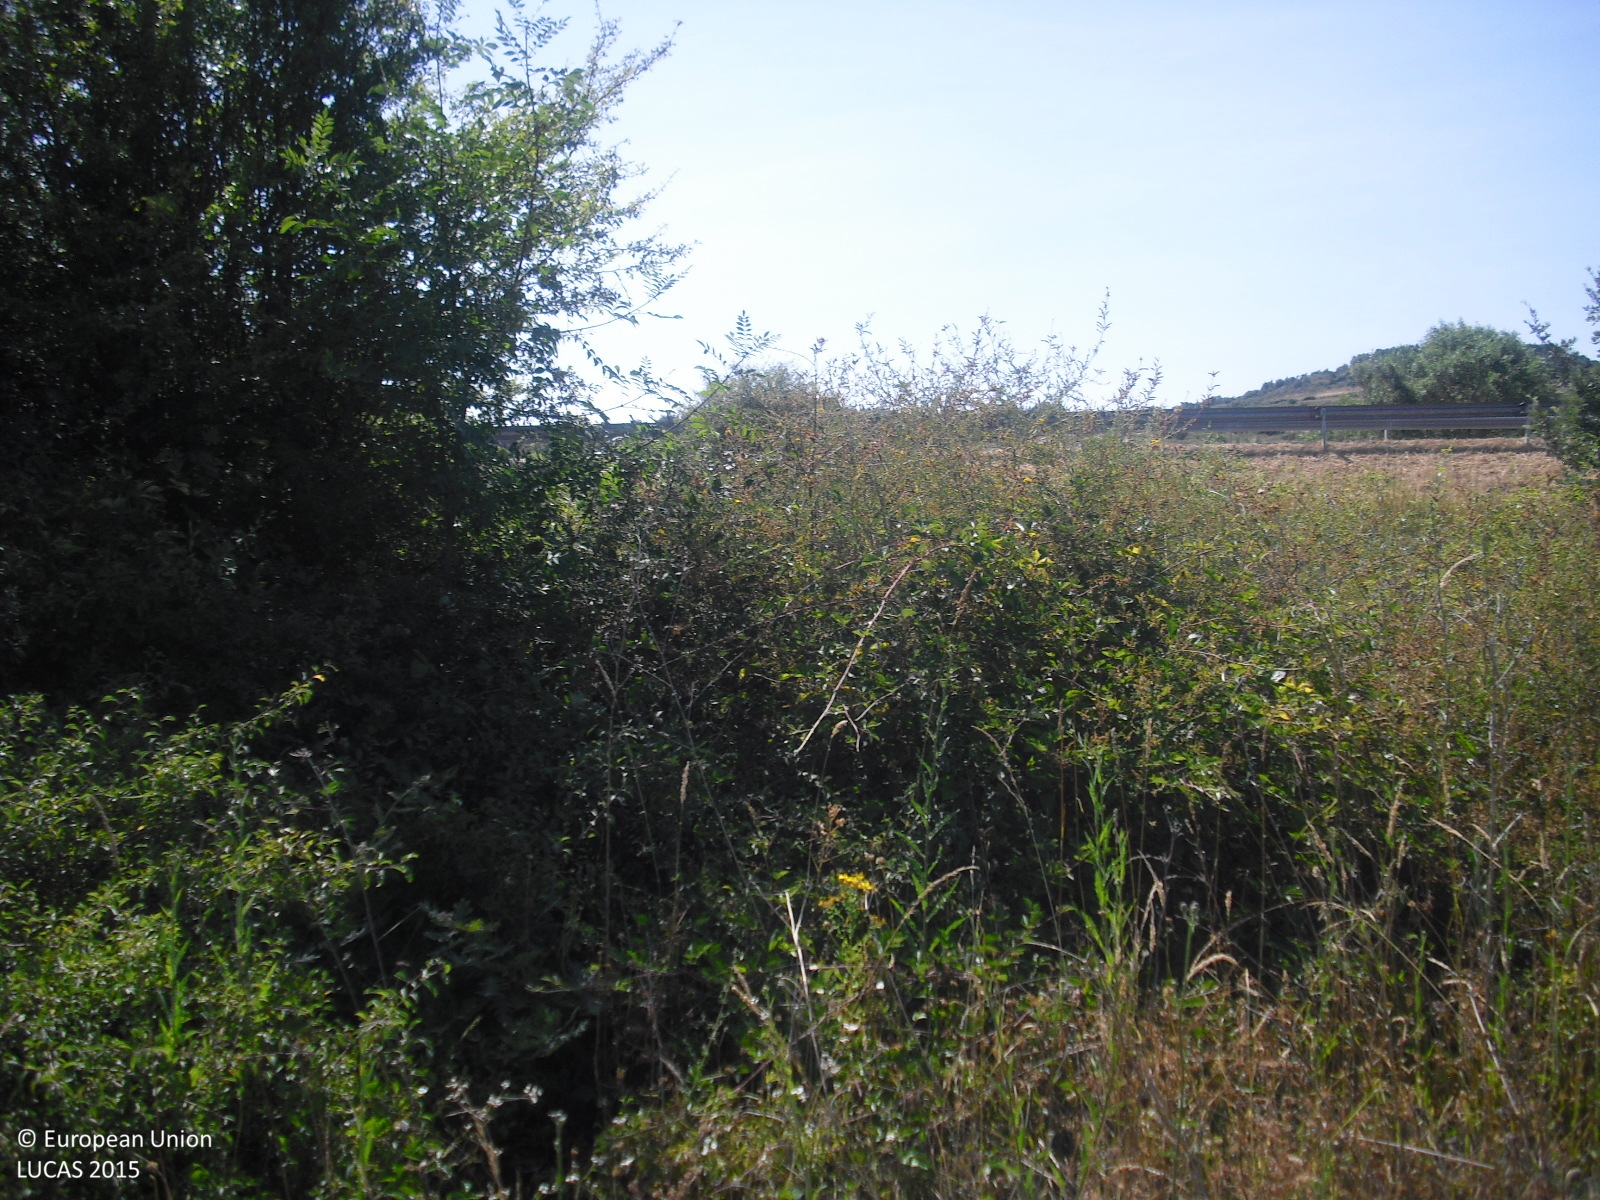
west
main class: Shrubland
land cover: Shrubland with sparse tree cover
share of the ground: 50 - 75 %
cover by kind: shrubs 60 %, herbaceous plants 35 %, broadleaved forest trees 5 %
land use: Abandoned areas
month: July
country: ES
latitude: 42.5547
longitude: -7.4981
